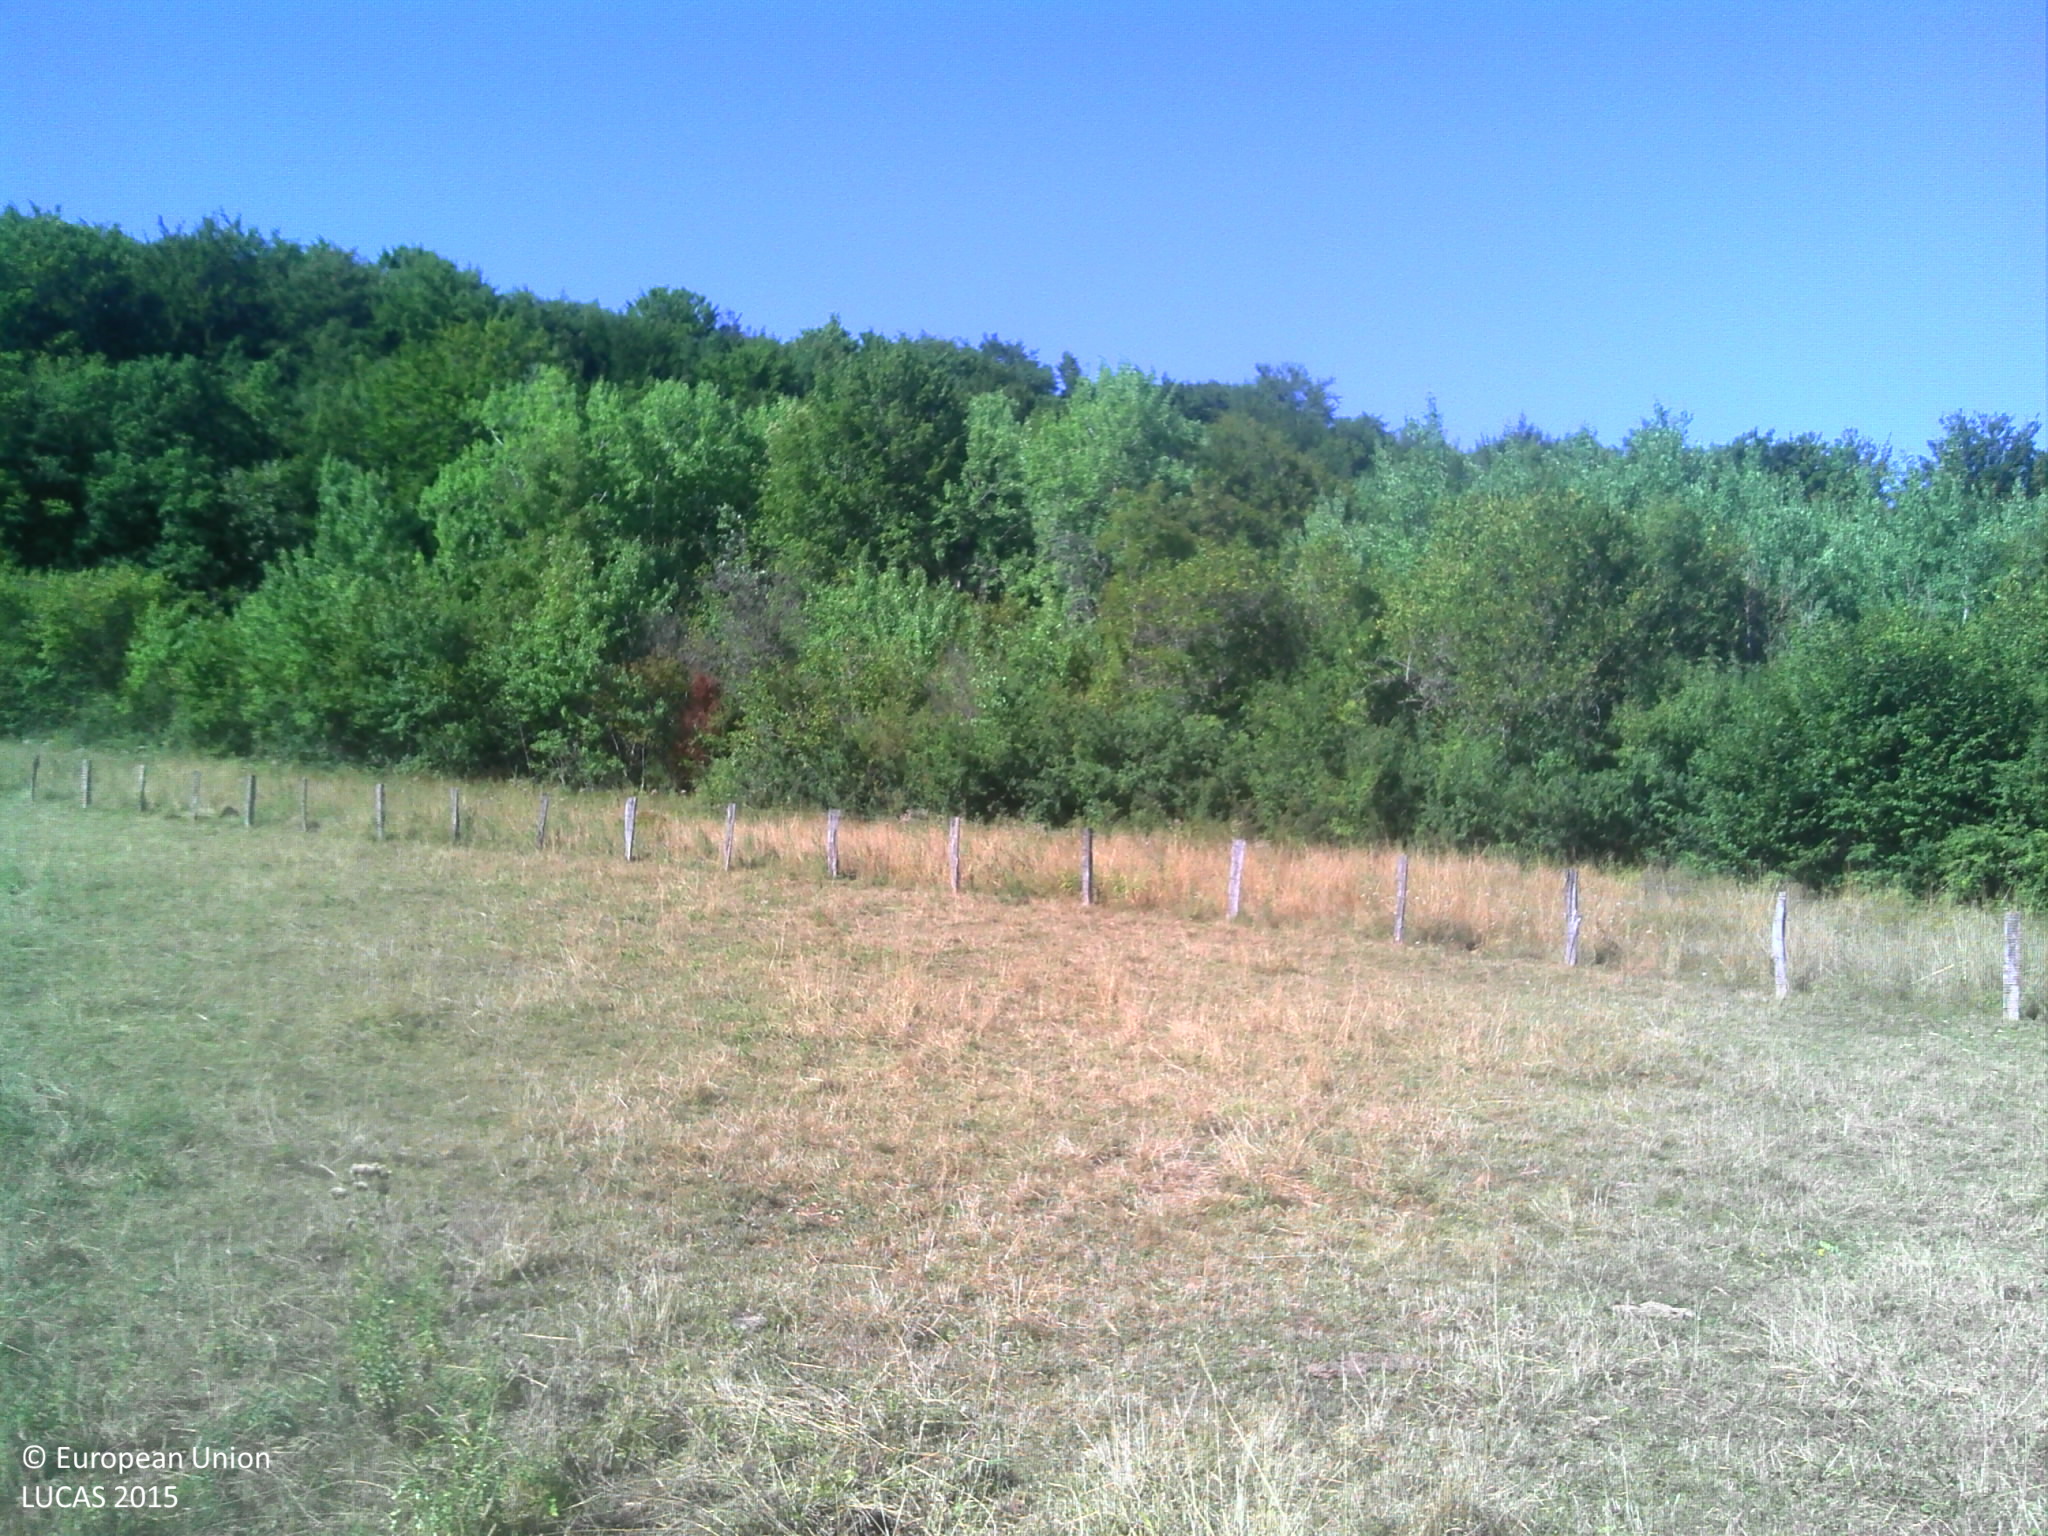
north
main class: Grassland
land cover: Grassland without tree/shrub cover
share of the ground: > 75 %
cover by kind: herbaceous plants 100 %
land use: Agriculture (excluding fallow land and kitchen gardens)
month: August
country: FR
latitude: 47.7531
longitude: 5.0776
